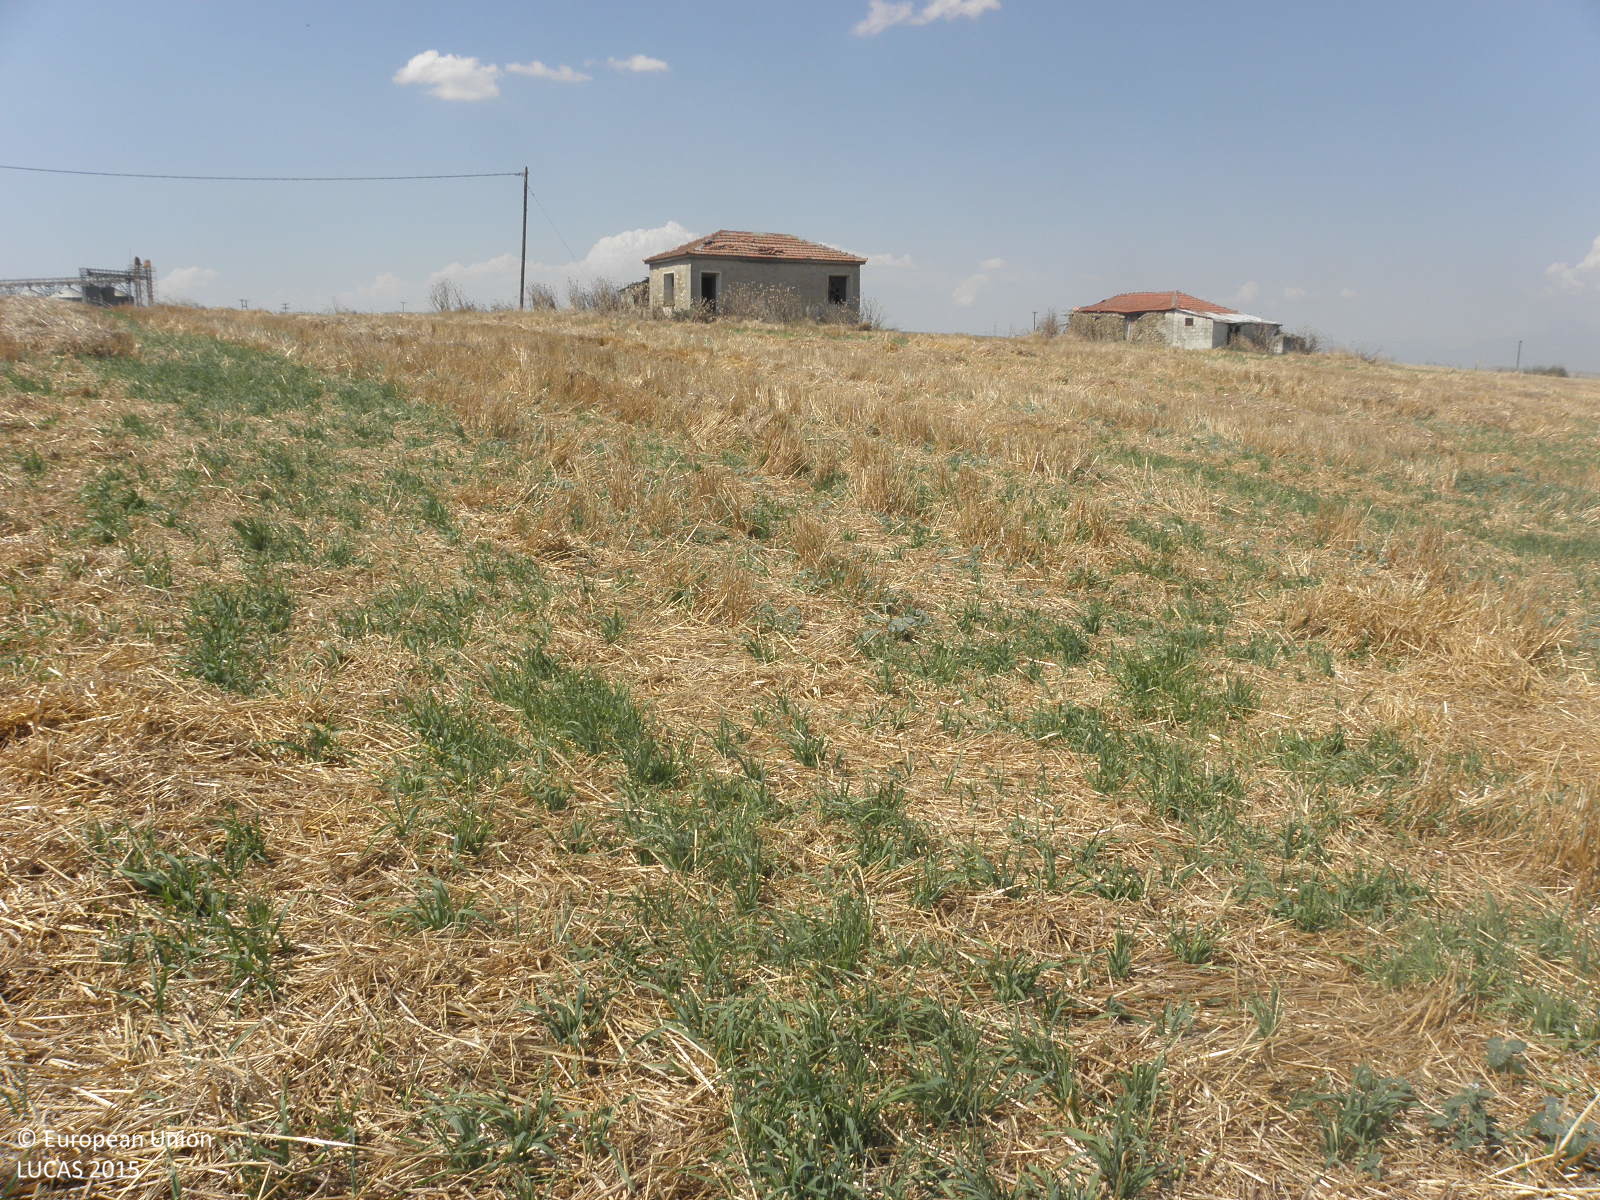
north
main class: Cropland
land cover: Durum wheat
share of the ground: > 75 %
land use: Agriculture (excluding fallow land and kitchen gardens)
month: July
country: GR
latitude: 39.4457
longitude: 22.3621
